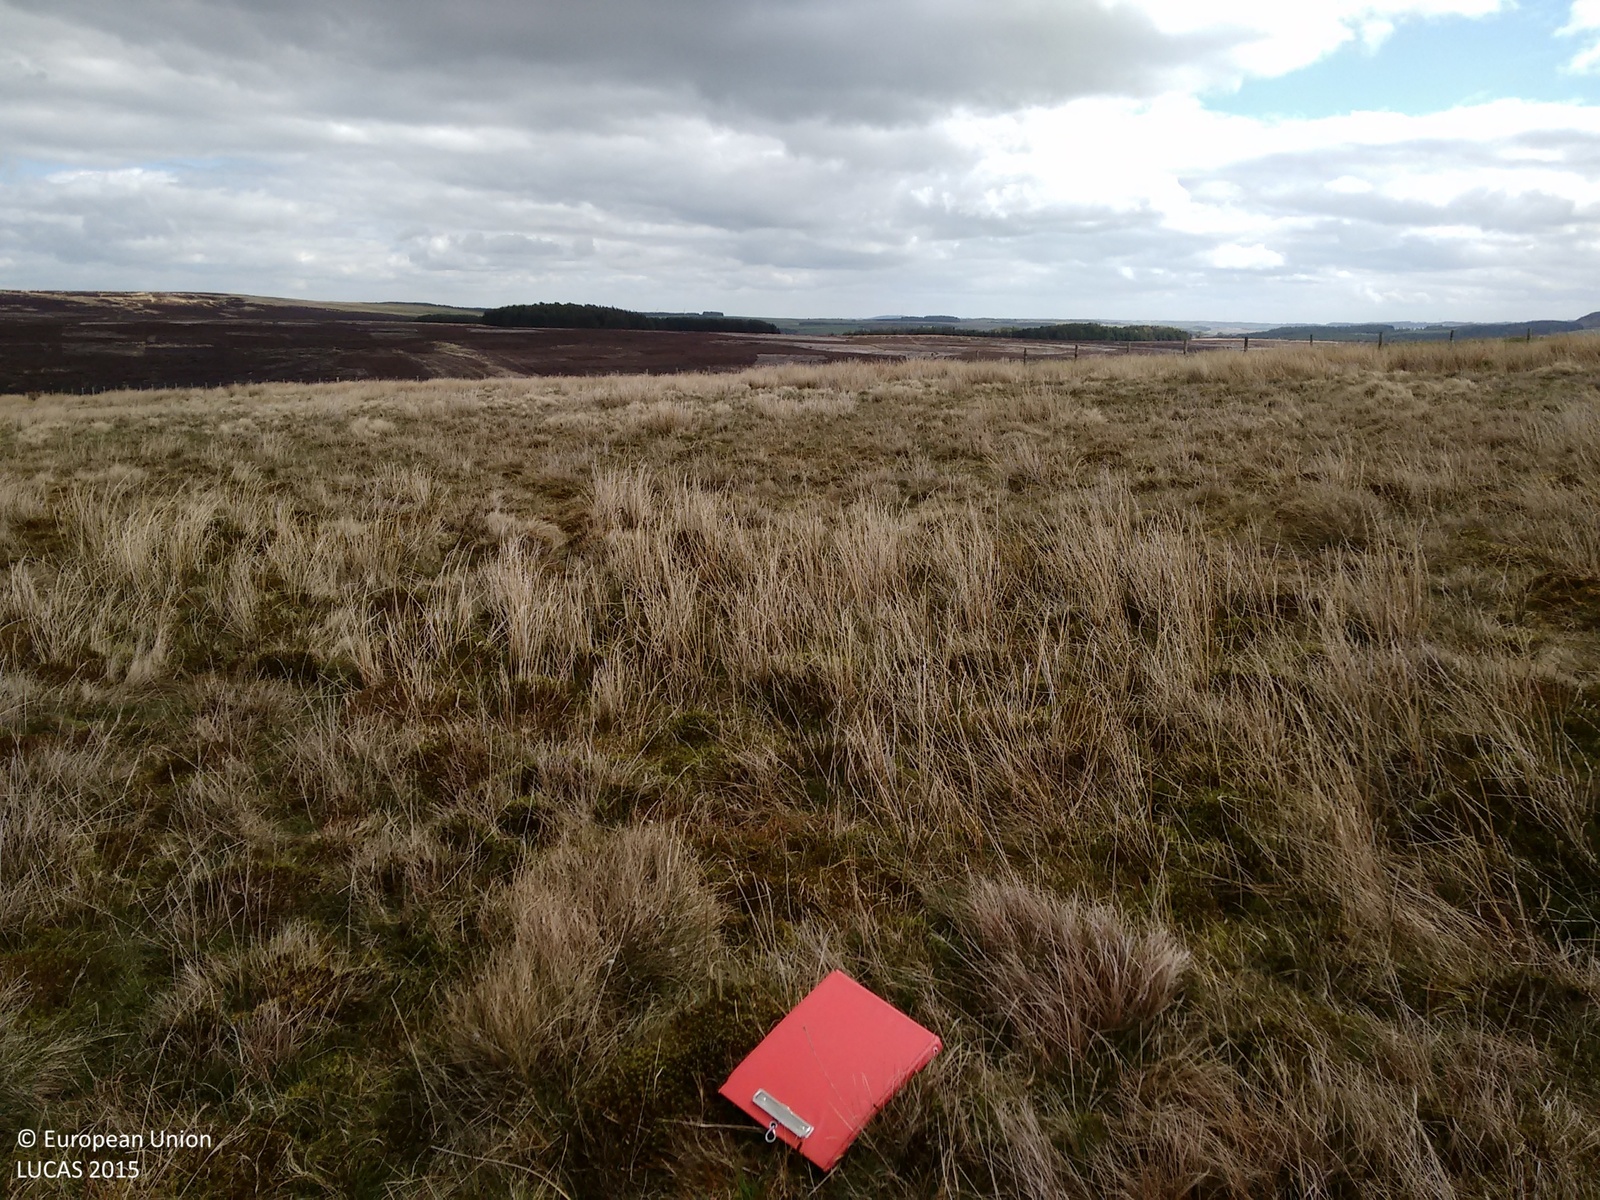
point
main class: Grassland
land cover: Grassland without tree/shrub cover
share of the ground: > 75 %
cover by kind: herbaceous plants 100 %
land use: Agriculture (excluding fallow land and kitchen gardens)
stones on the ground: < 10 %
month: May
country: GB
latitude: 54.8723
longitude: -2.0392
